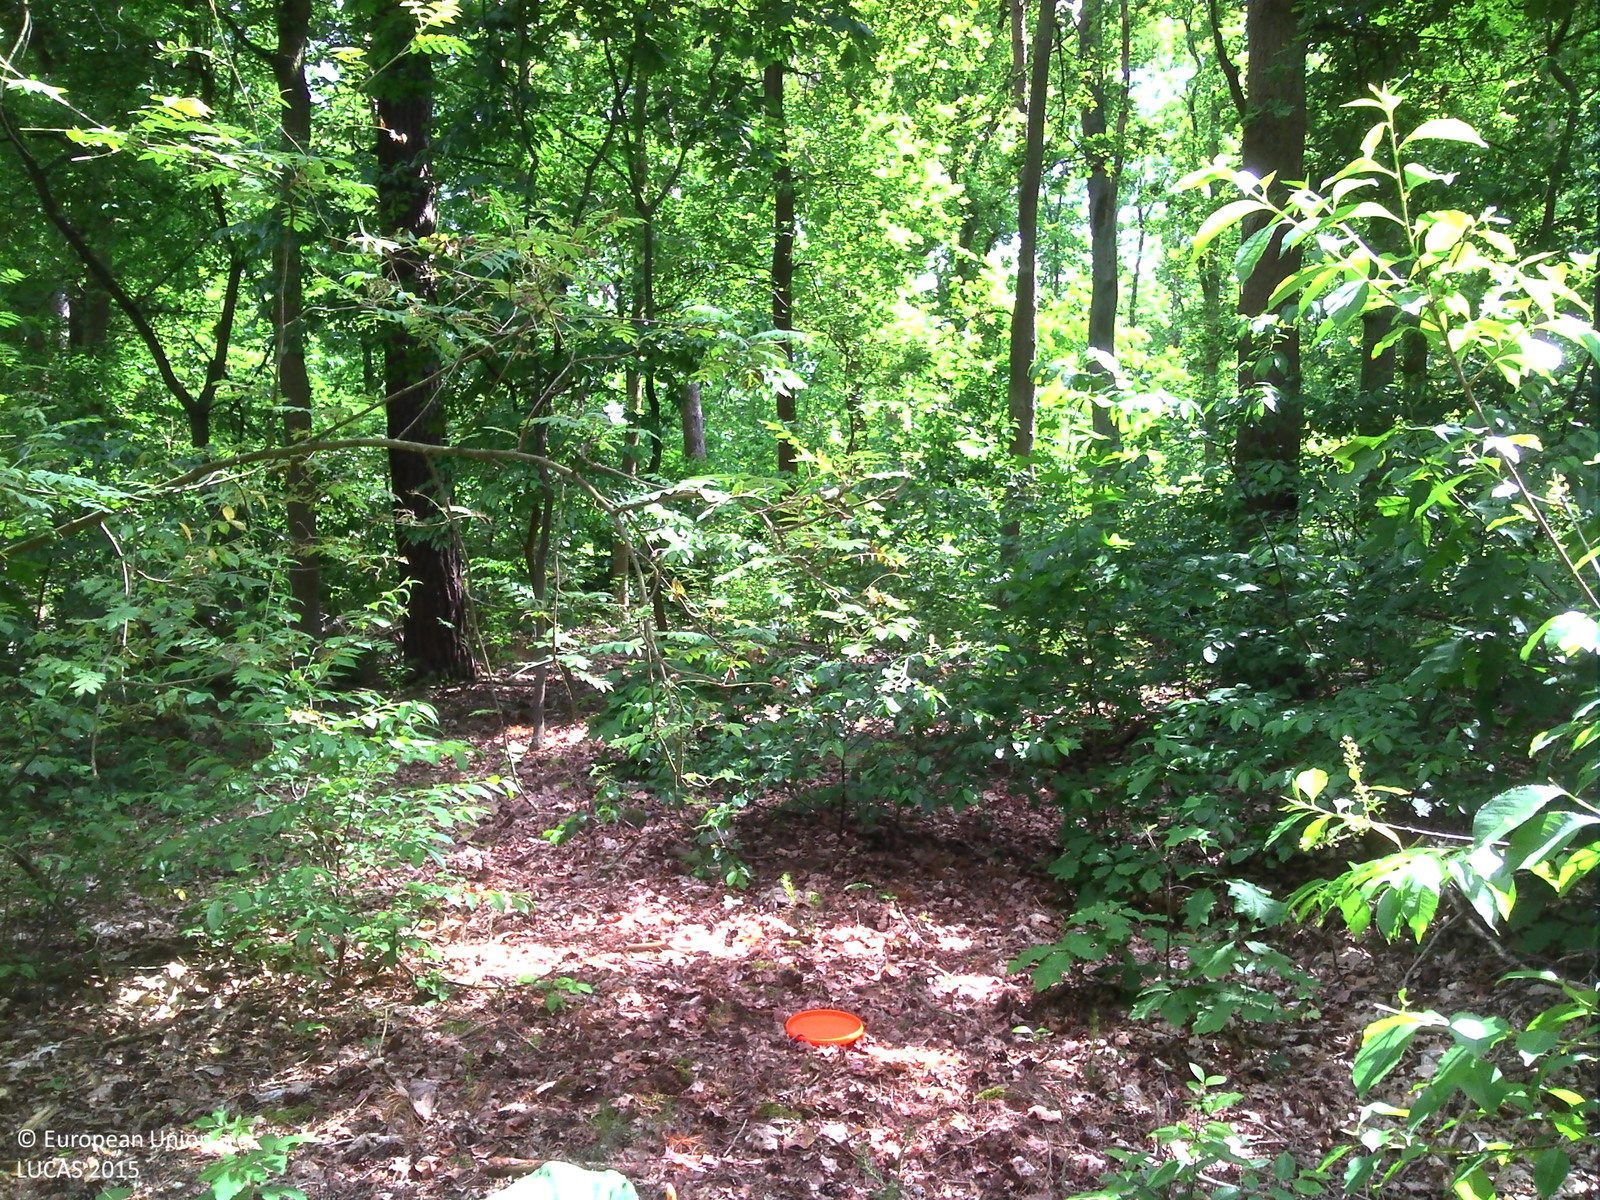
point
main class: Woodland
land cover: Pine dominated mixed woodland
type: exotic forest
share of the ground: > 75 %
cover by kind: broadleaved forest trees 70 %, coniferous forest trees 25 %, herbaceous plants 5 %
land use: Forestry
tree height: > 5 m
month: June
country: BE
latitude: 51.0756
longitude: 5.7023
